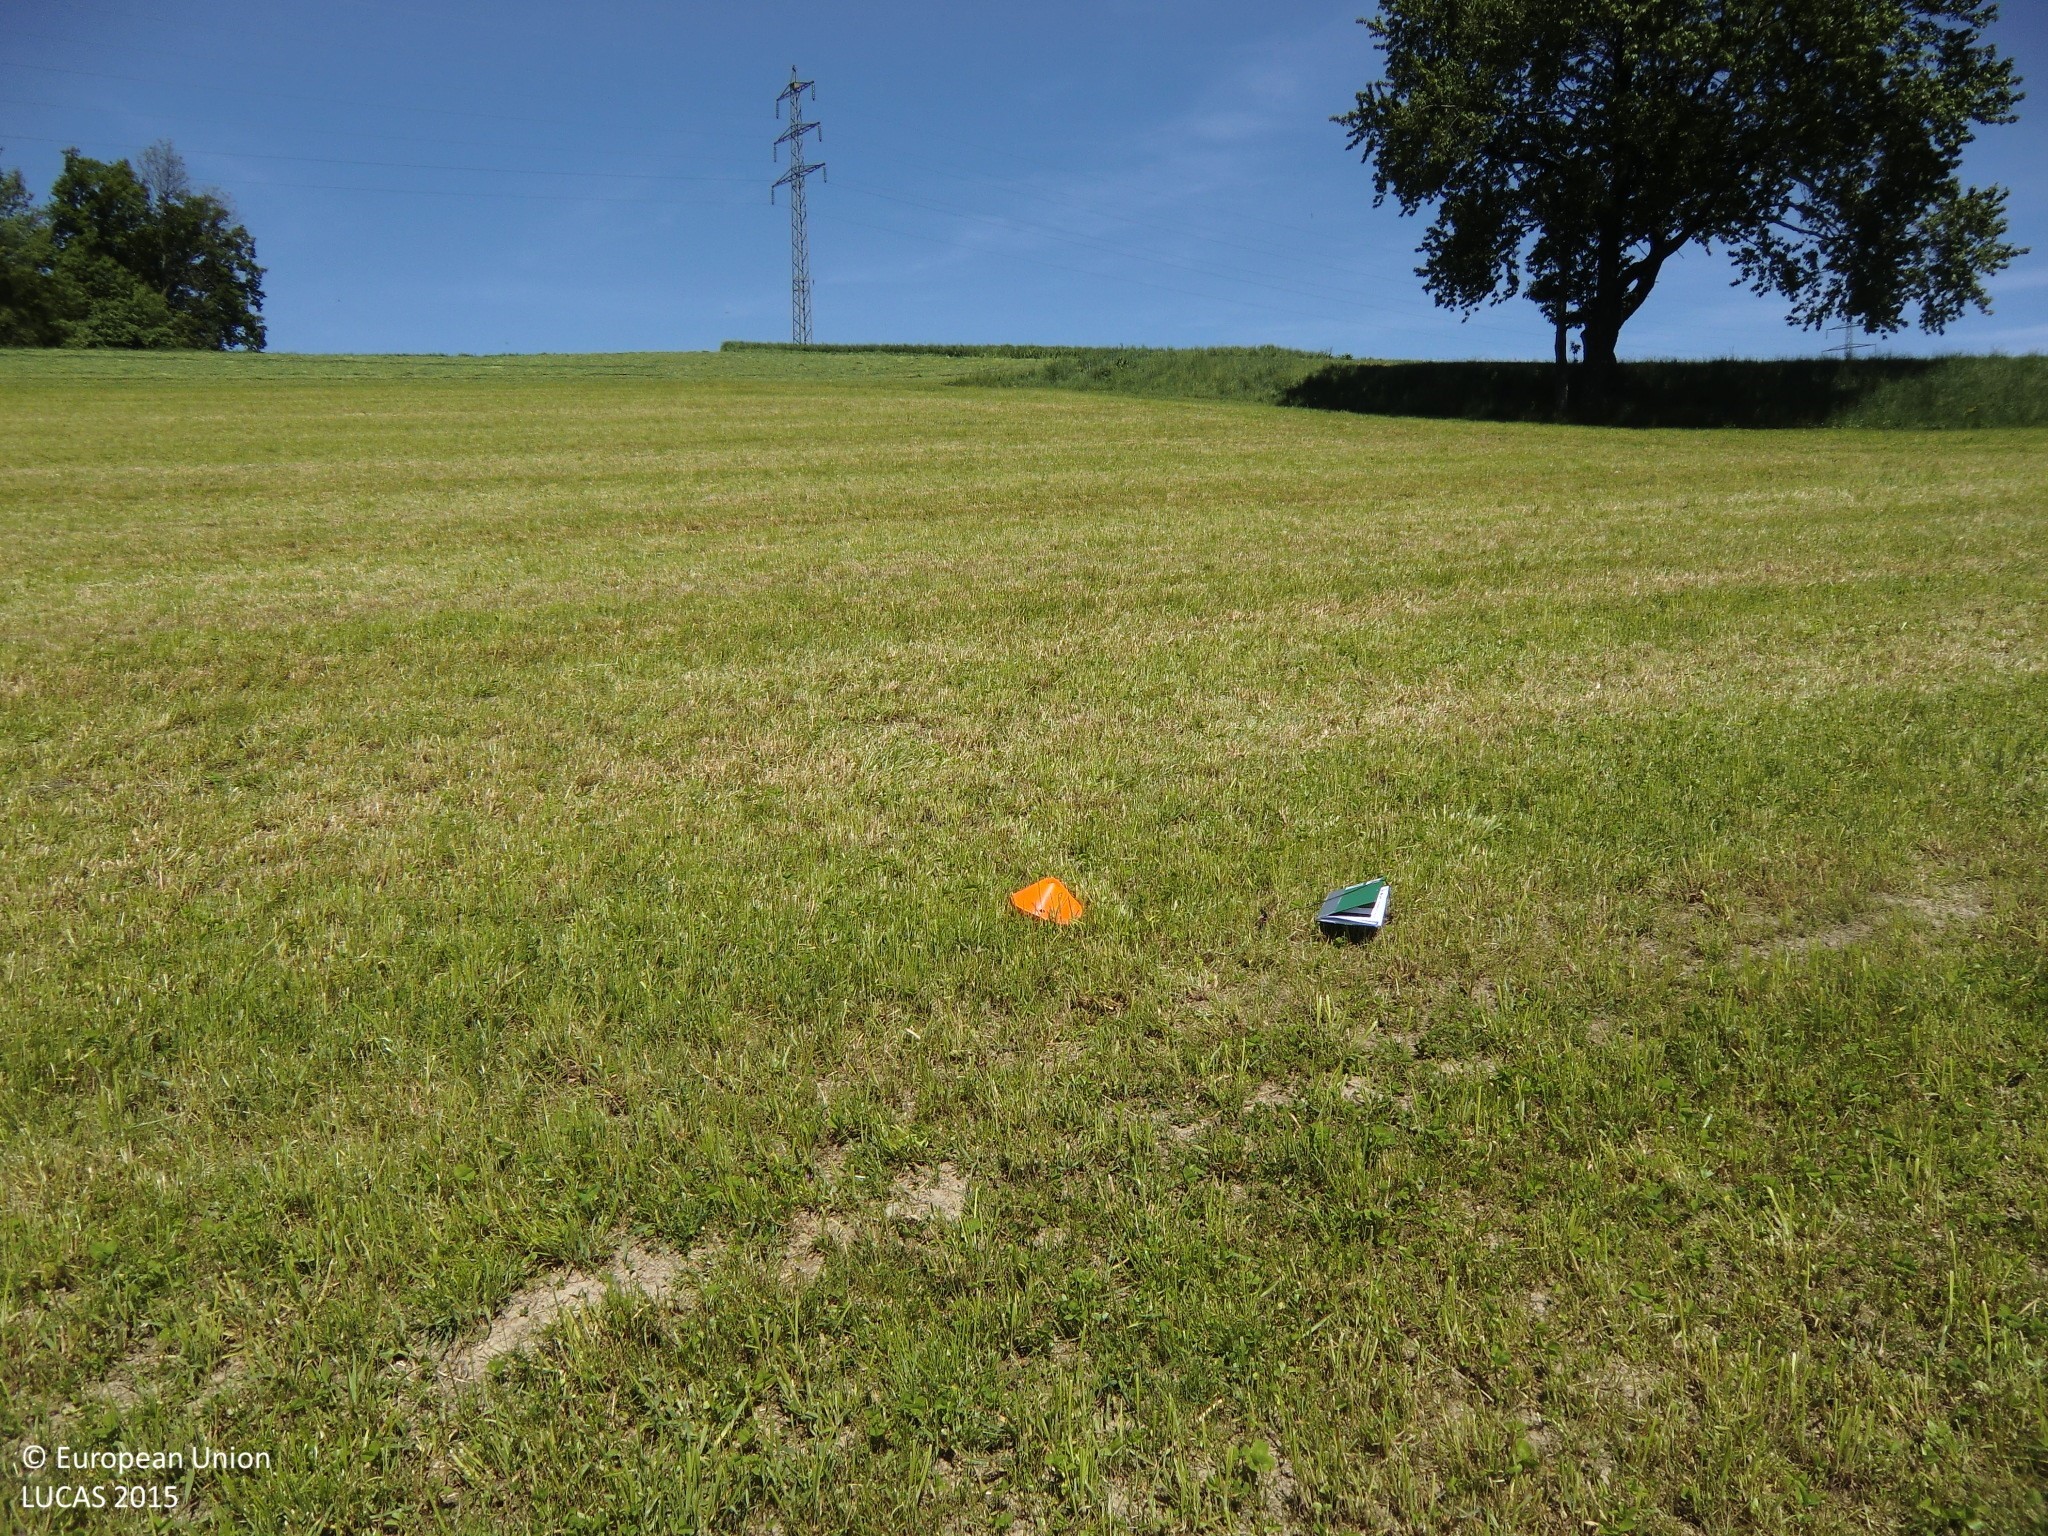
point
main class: Grassland
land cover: Grassland without tree/shrub cover
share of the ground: > 75 %
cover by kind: herbaceous plants 100 %
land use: Agriculture (excluding fallow land and kitchen gardens)
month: May
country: AT
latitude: 48.0766
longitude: 15.3304
